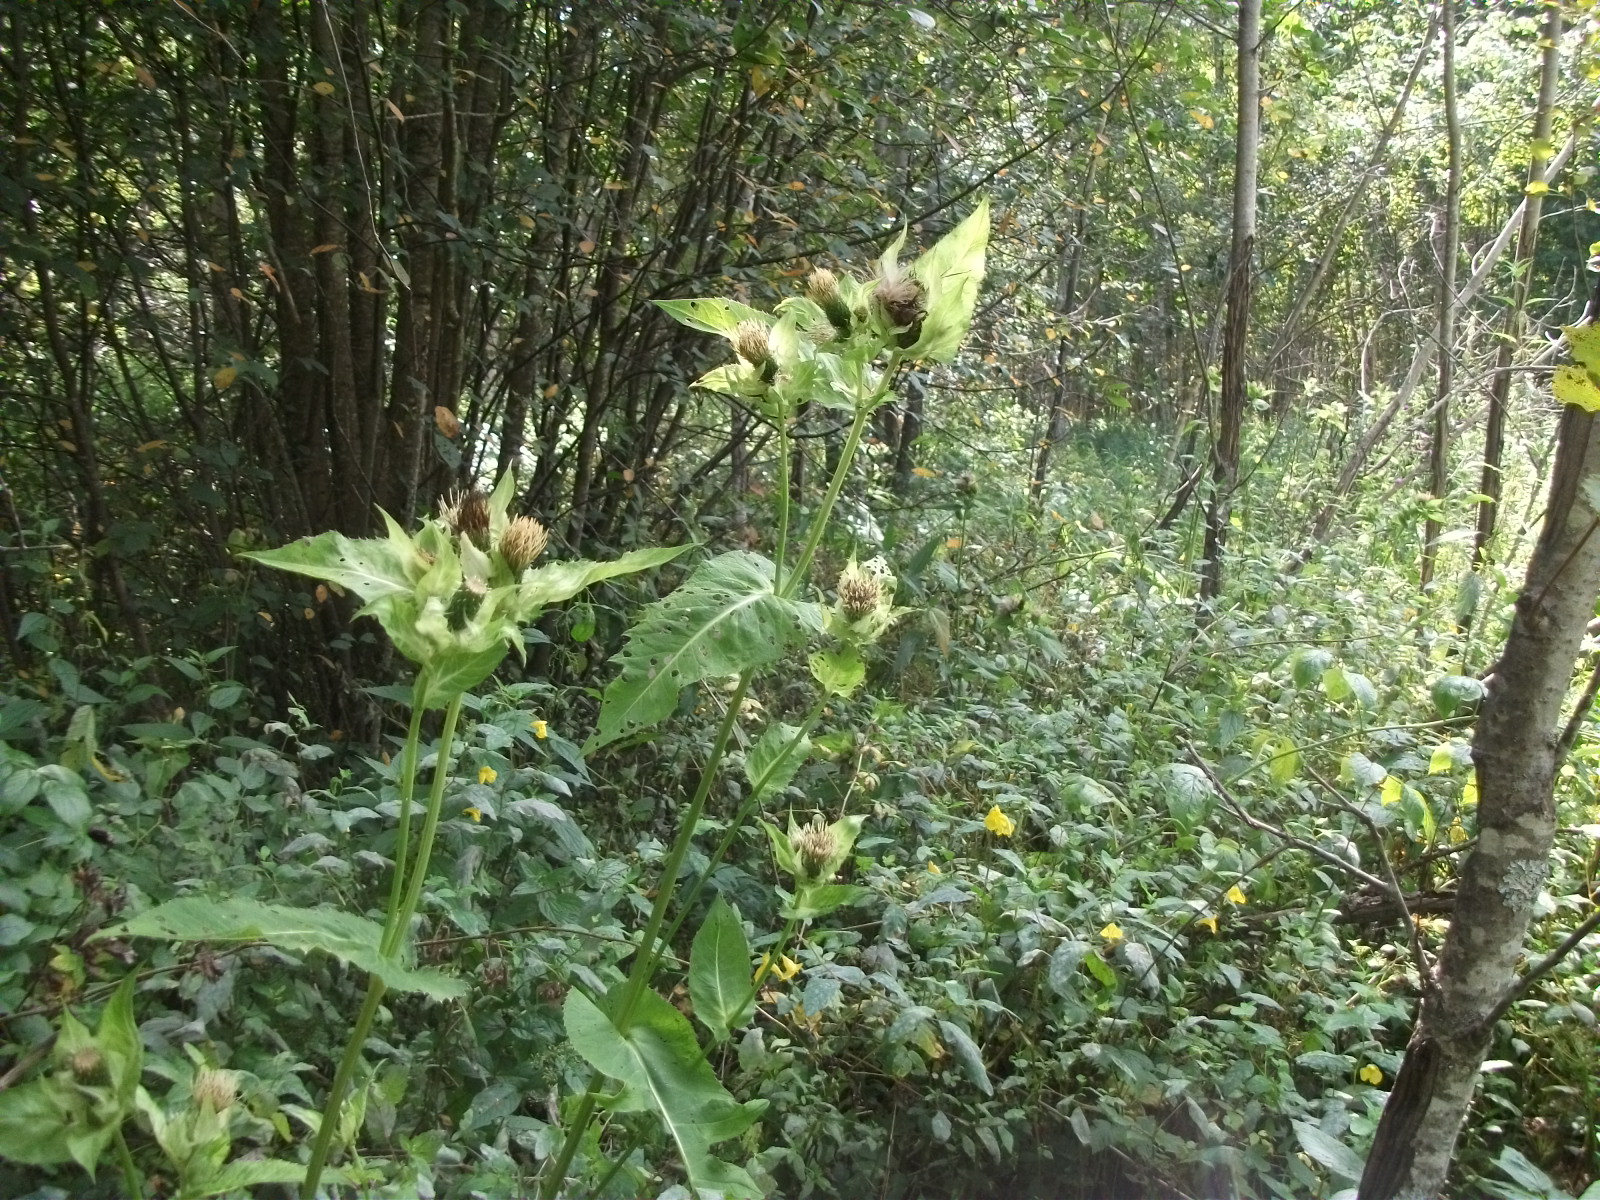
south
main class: Woodland
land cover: Broadleaved woodland
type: non-riverine alder, birch or aspen forest
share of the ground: 50 - 75 %
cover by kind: broadleaved forest trees 70 %, herbaceous plants 20 %, shrubs 10 %
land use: Forestry
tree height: > 5 m
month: August
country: LV
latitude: 56.8697
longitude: 26.4008
